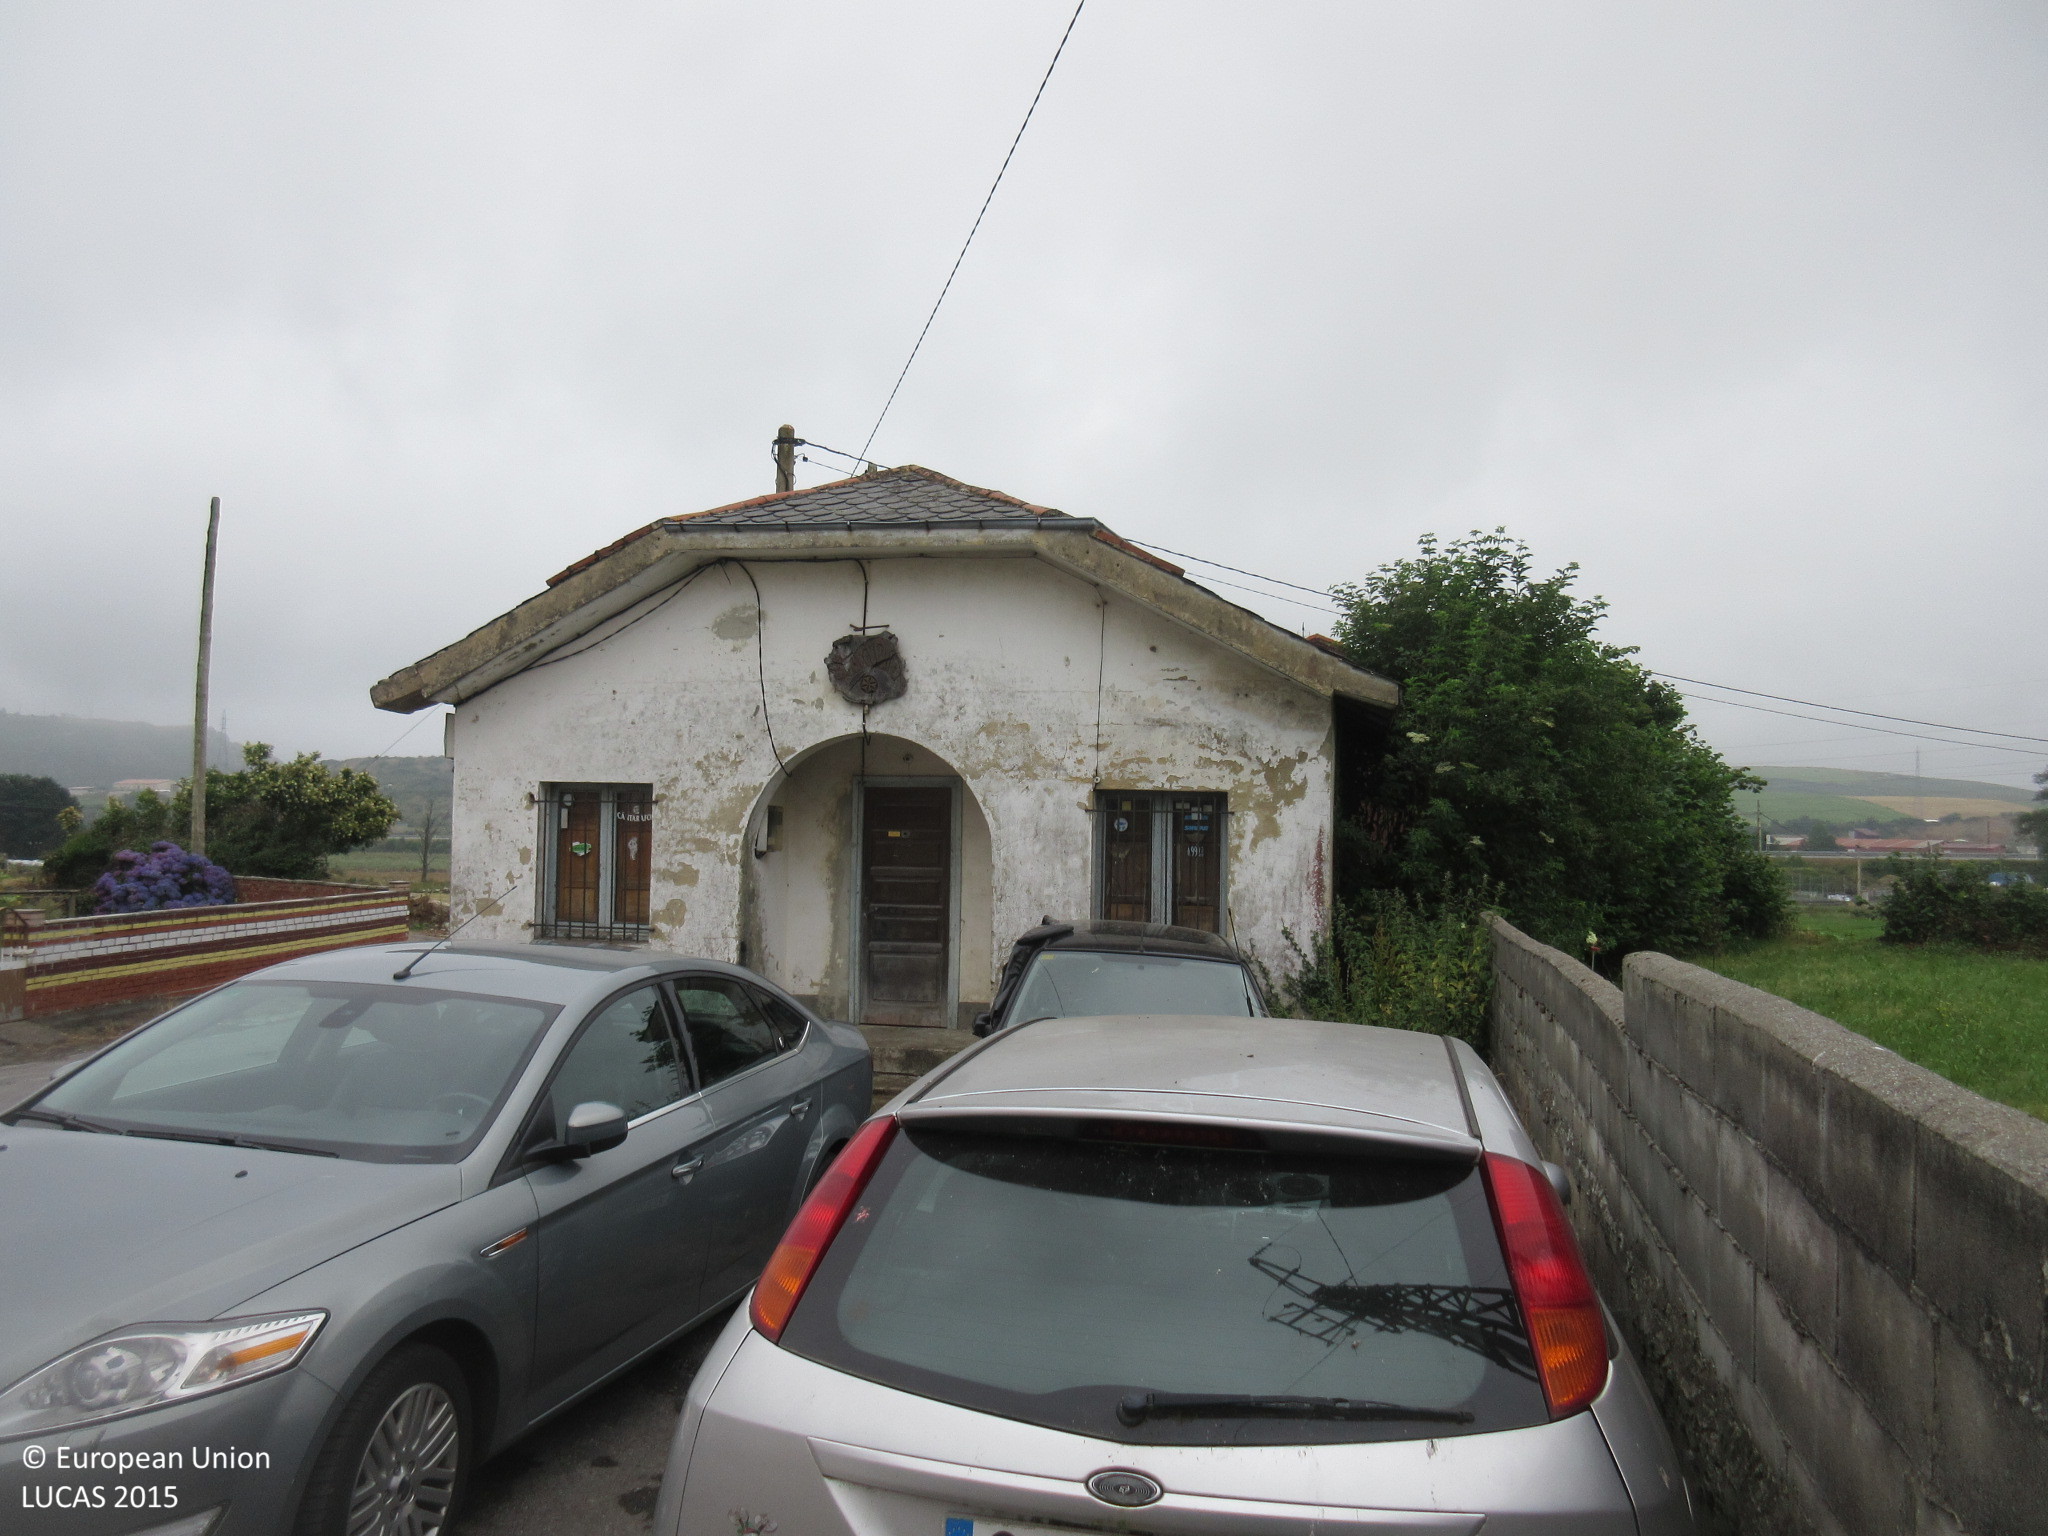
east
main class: Grassland
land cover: Grassland without tree/shrub cover
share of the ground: > 75 %
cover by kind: herbaceous plants 100 %
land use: Agriculture (excluding fallow land and kitchen gardens)
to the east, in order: Grassland without tree/shrub cover; Electric lines; Abandoned hedges; Grassland without tree/shrub cover; Artificial constructions in urban areas; Grassland without tree/shrub cover; Dry stone walls; Fences; Grassland without tree/shrub cover; Fences; Grassland without tree/shrub cover
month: July
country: ES
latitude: 43.3948
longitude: -6.3344
